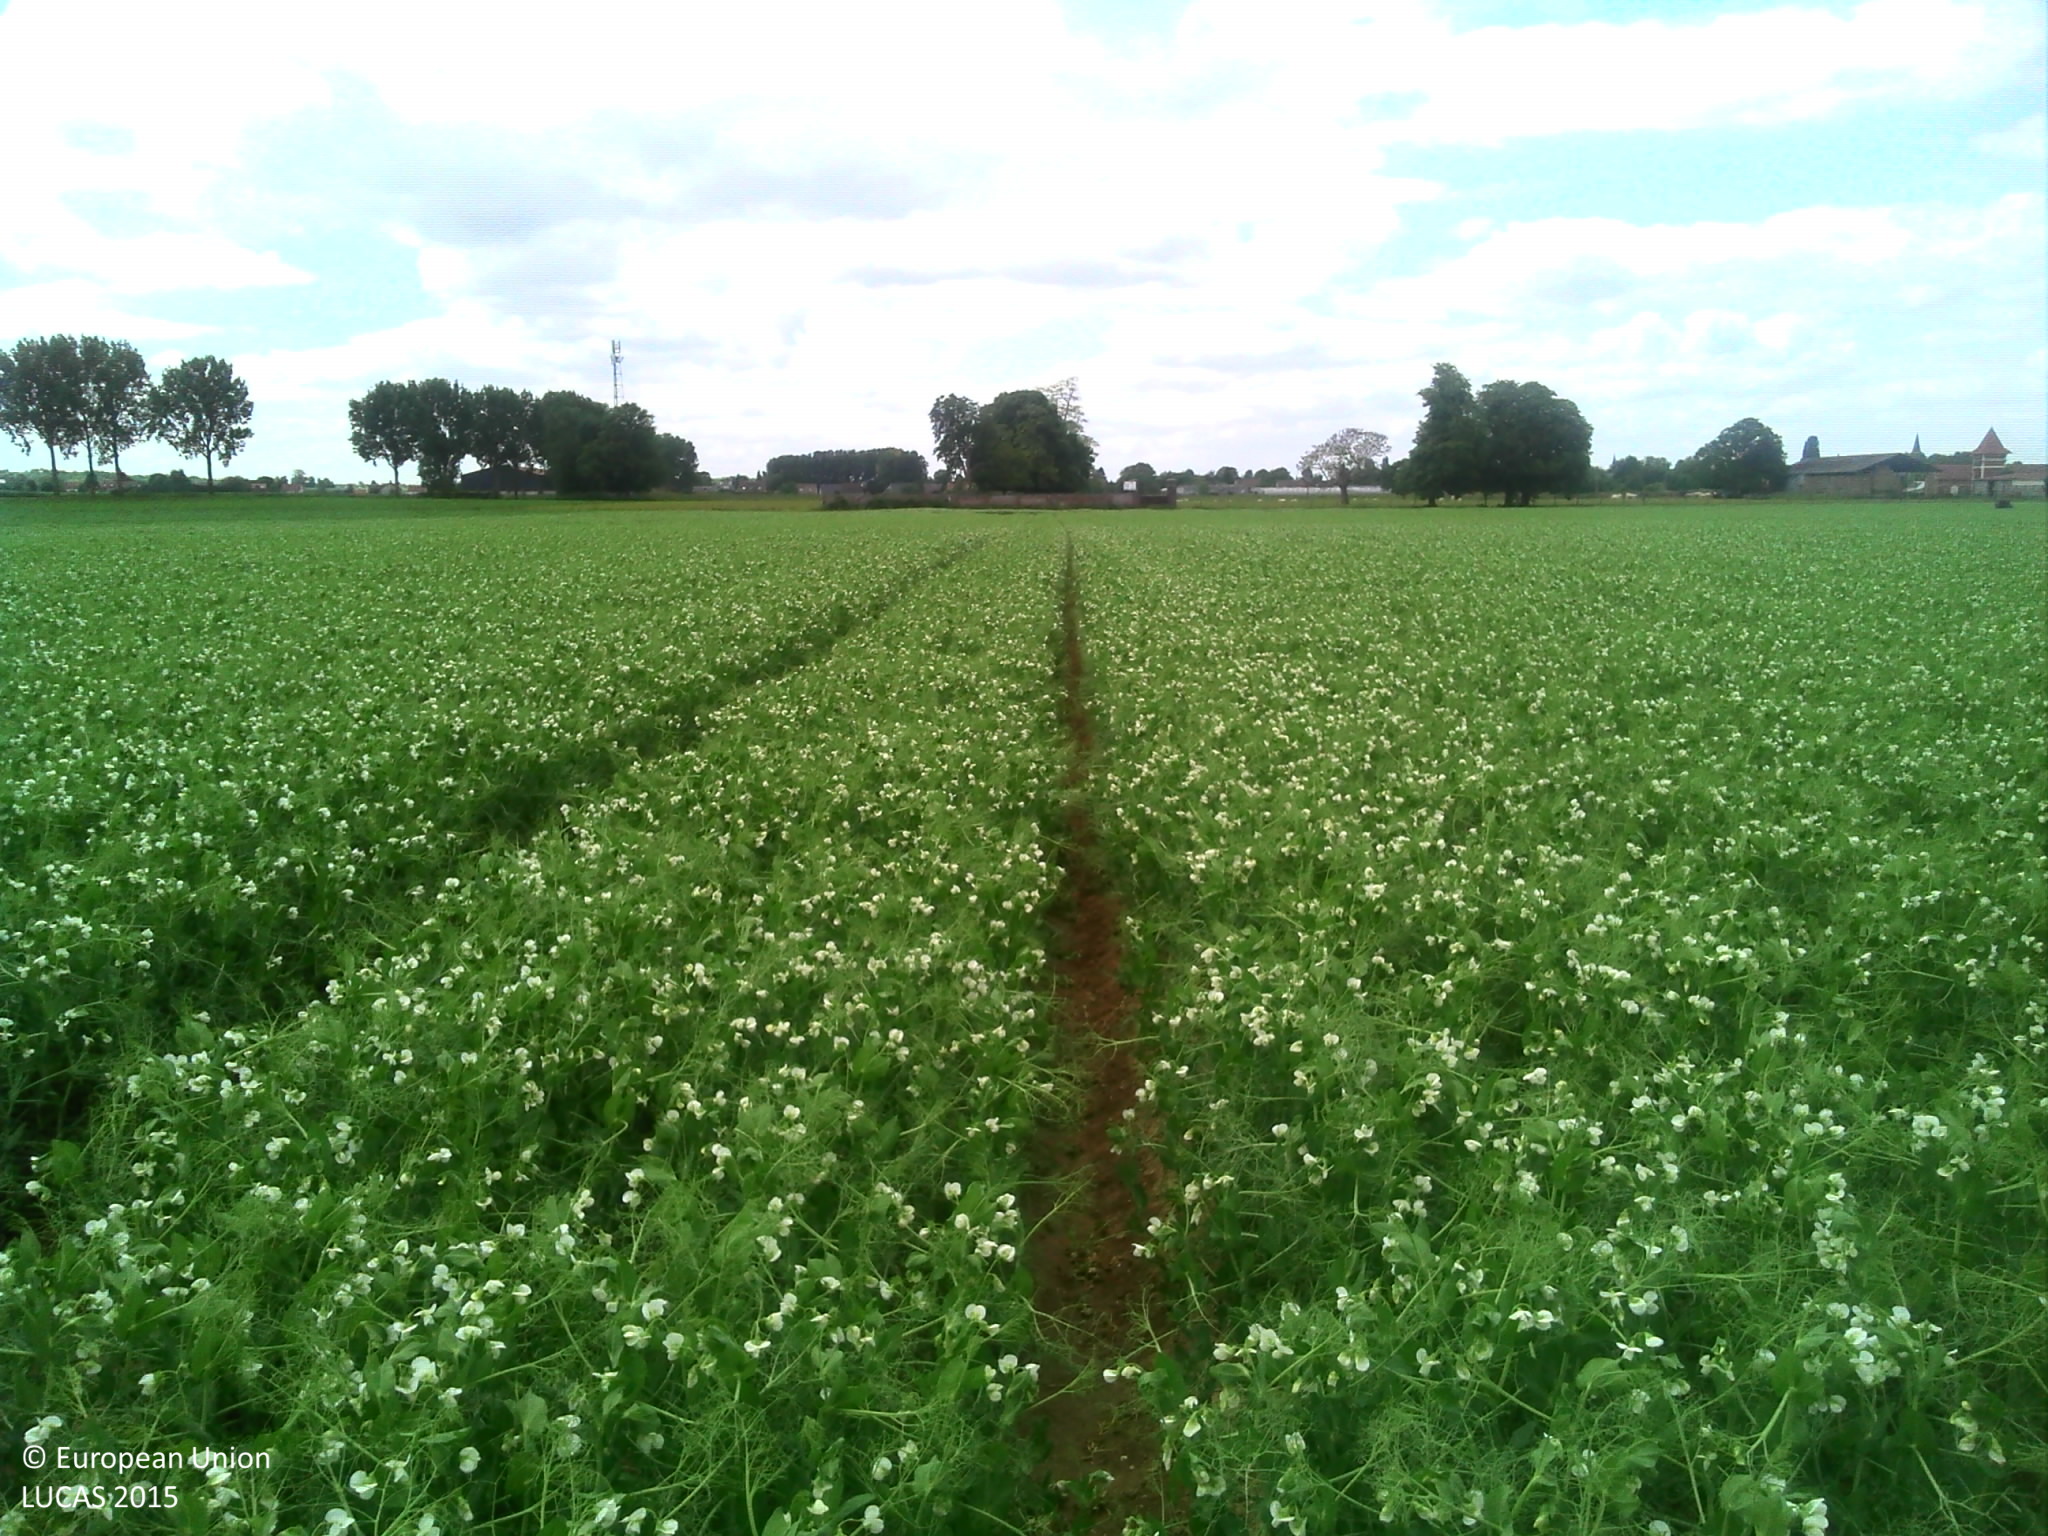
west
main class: Cropland
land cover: Dry pulses
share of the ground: > 75 %
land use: Agriculture (excluding fallow land and kitchen gardens)
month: June
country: FR
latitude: 49.7111
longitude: 3.2100
